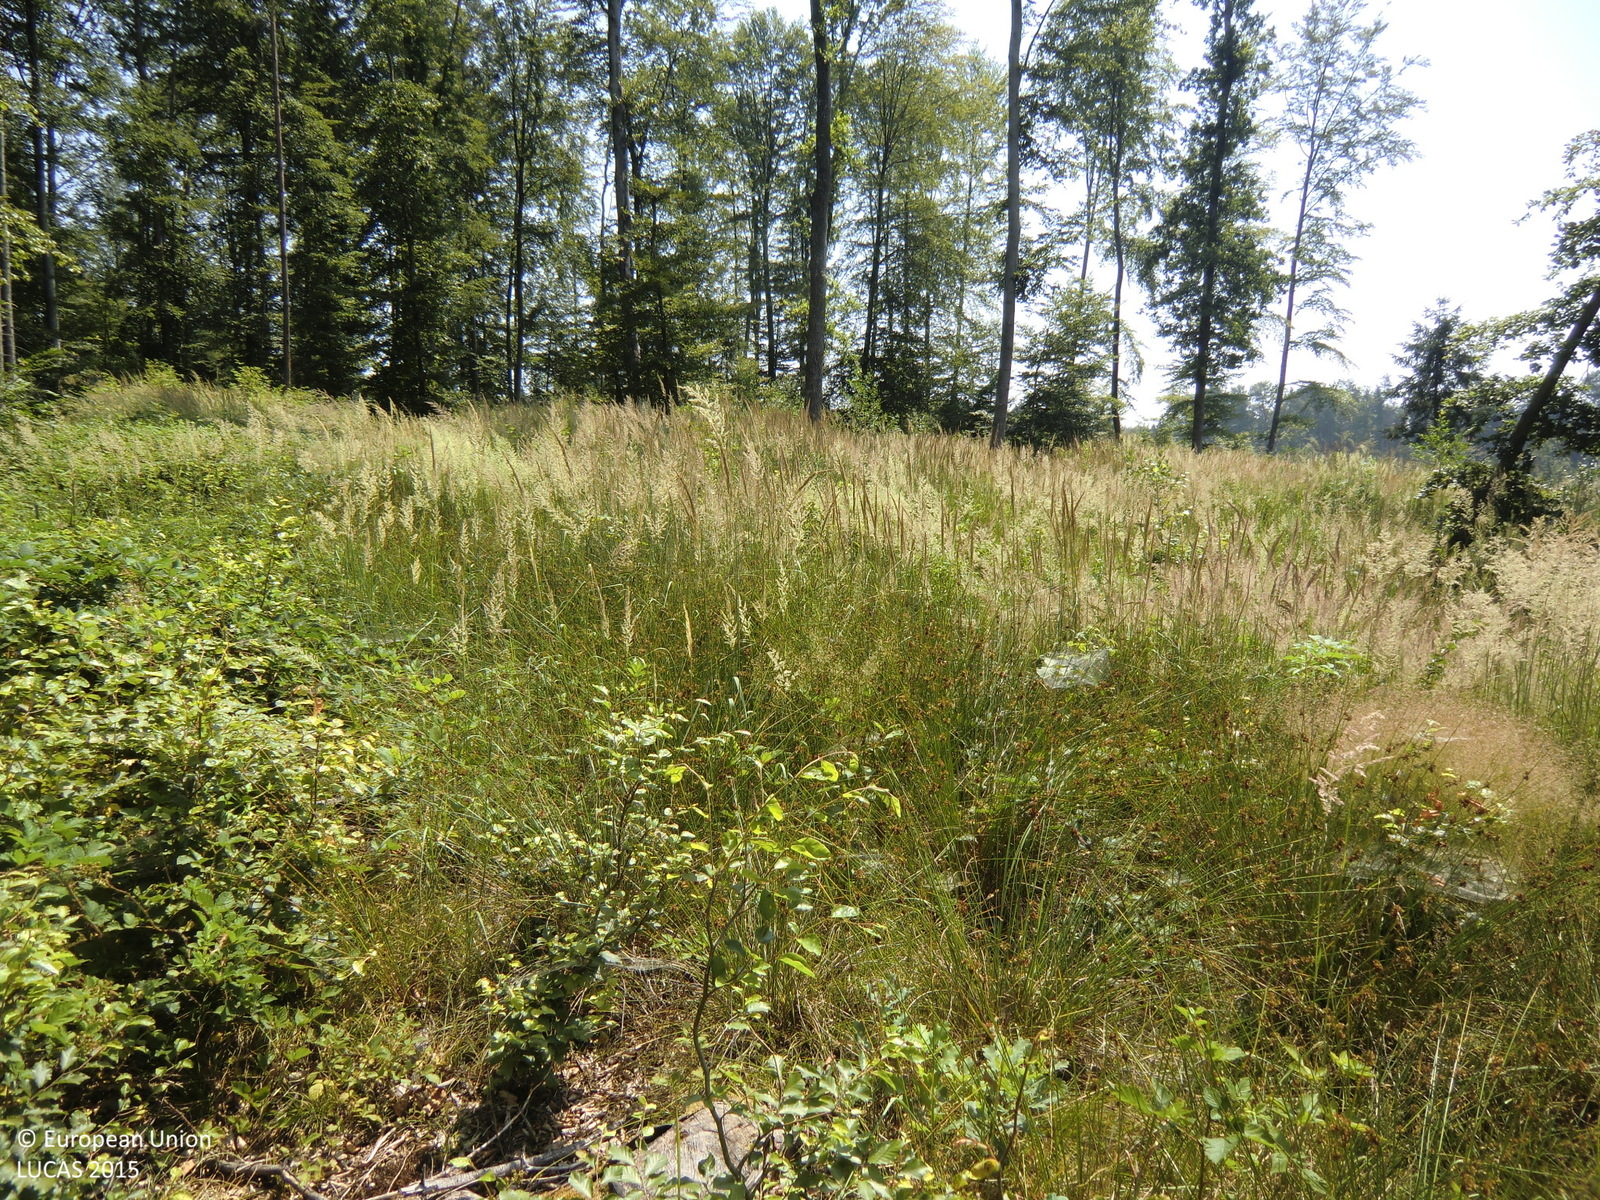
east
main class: Shrubland
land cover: Shrubland with sparse tree cover
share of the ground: > 75 %
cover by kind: herbaceous plants 55 %, shrubs 40 %, broadleaved forest trees 5 %
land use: Forestry
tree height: < 5 m
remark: Clear cut
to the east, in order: Shrubland with sparse tree cover; Pine dominated mixed woodland; Shrubland without tree cover
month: July
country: AT
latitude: 47.1001
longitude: 15.7320
